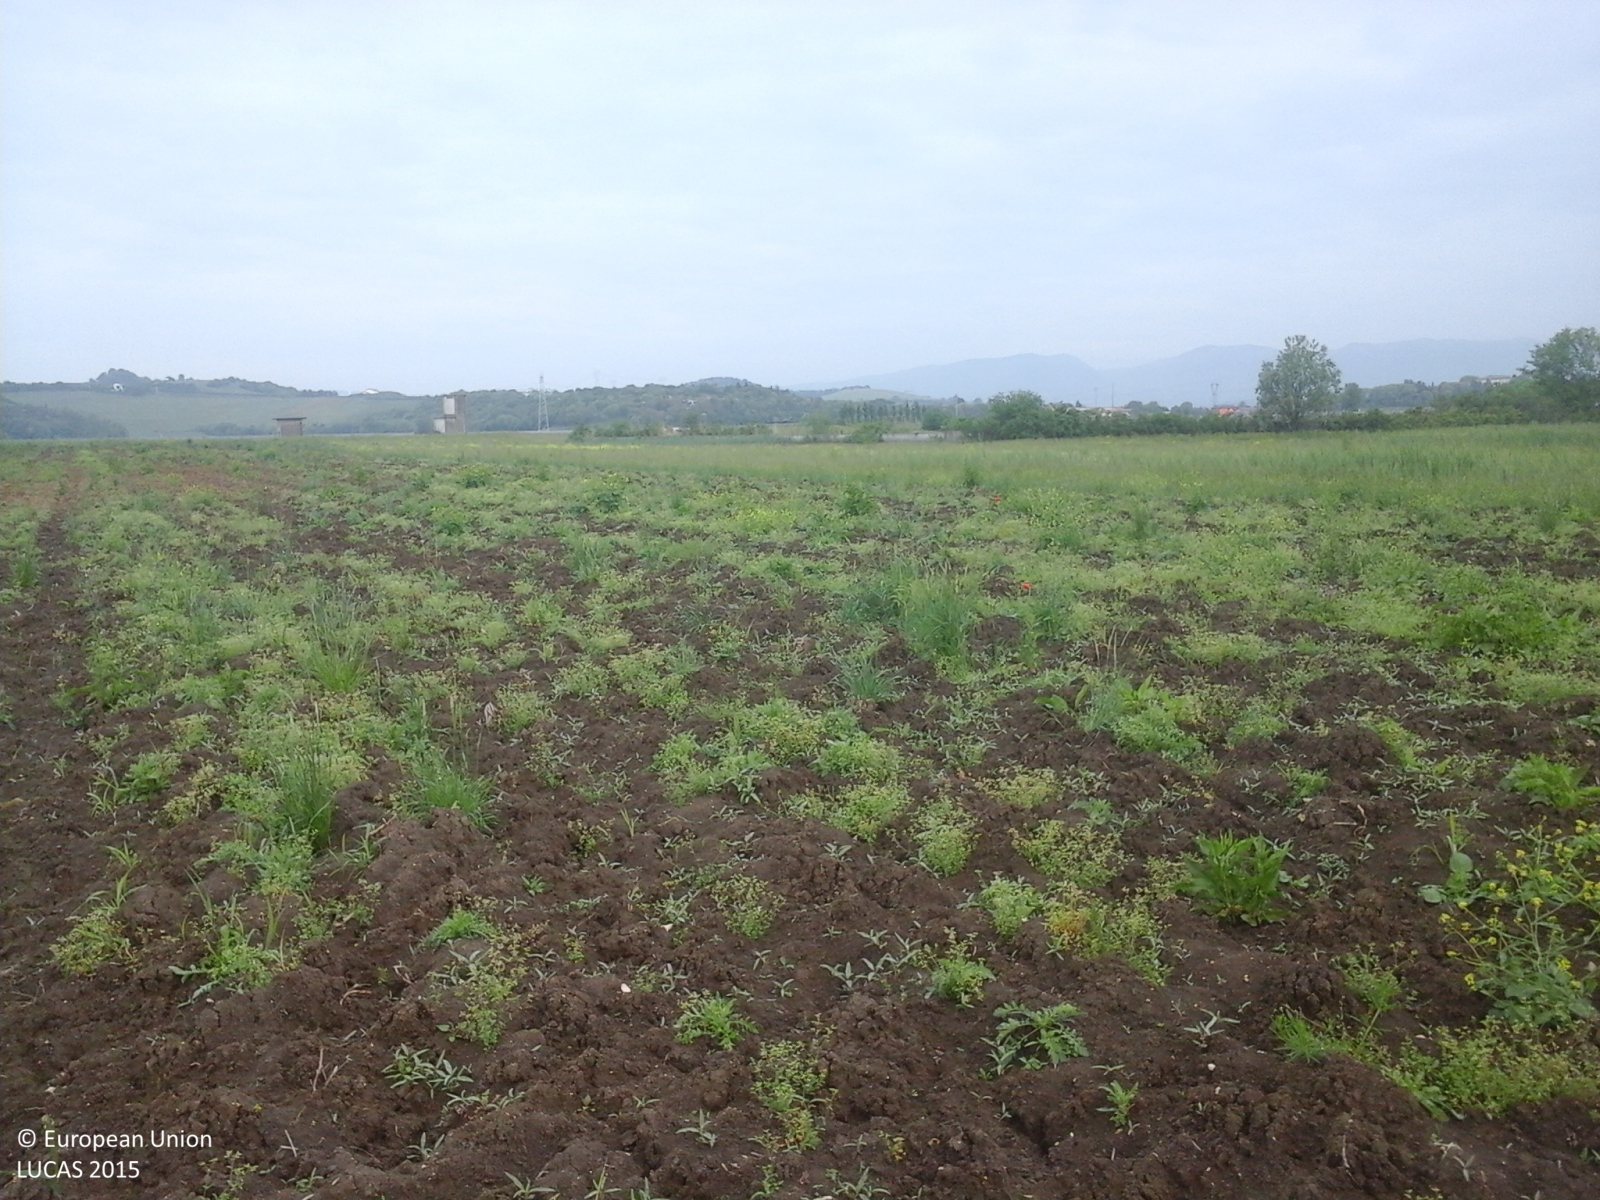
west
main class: Grassland
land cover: Spontaneously vegetated surfaces
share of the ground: 25 - 50 %
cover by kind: consolidated bare surface 80 %, herbaceous plants 20 %
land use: Fallow land
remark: Tilled/Sowed
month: May
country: IT
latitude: 45.3658
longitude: 11.6187
